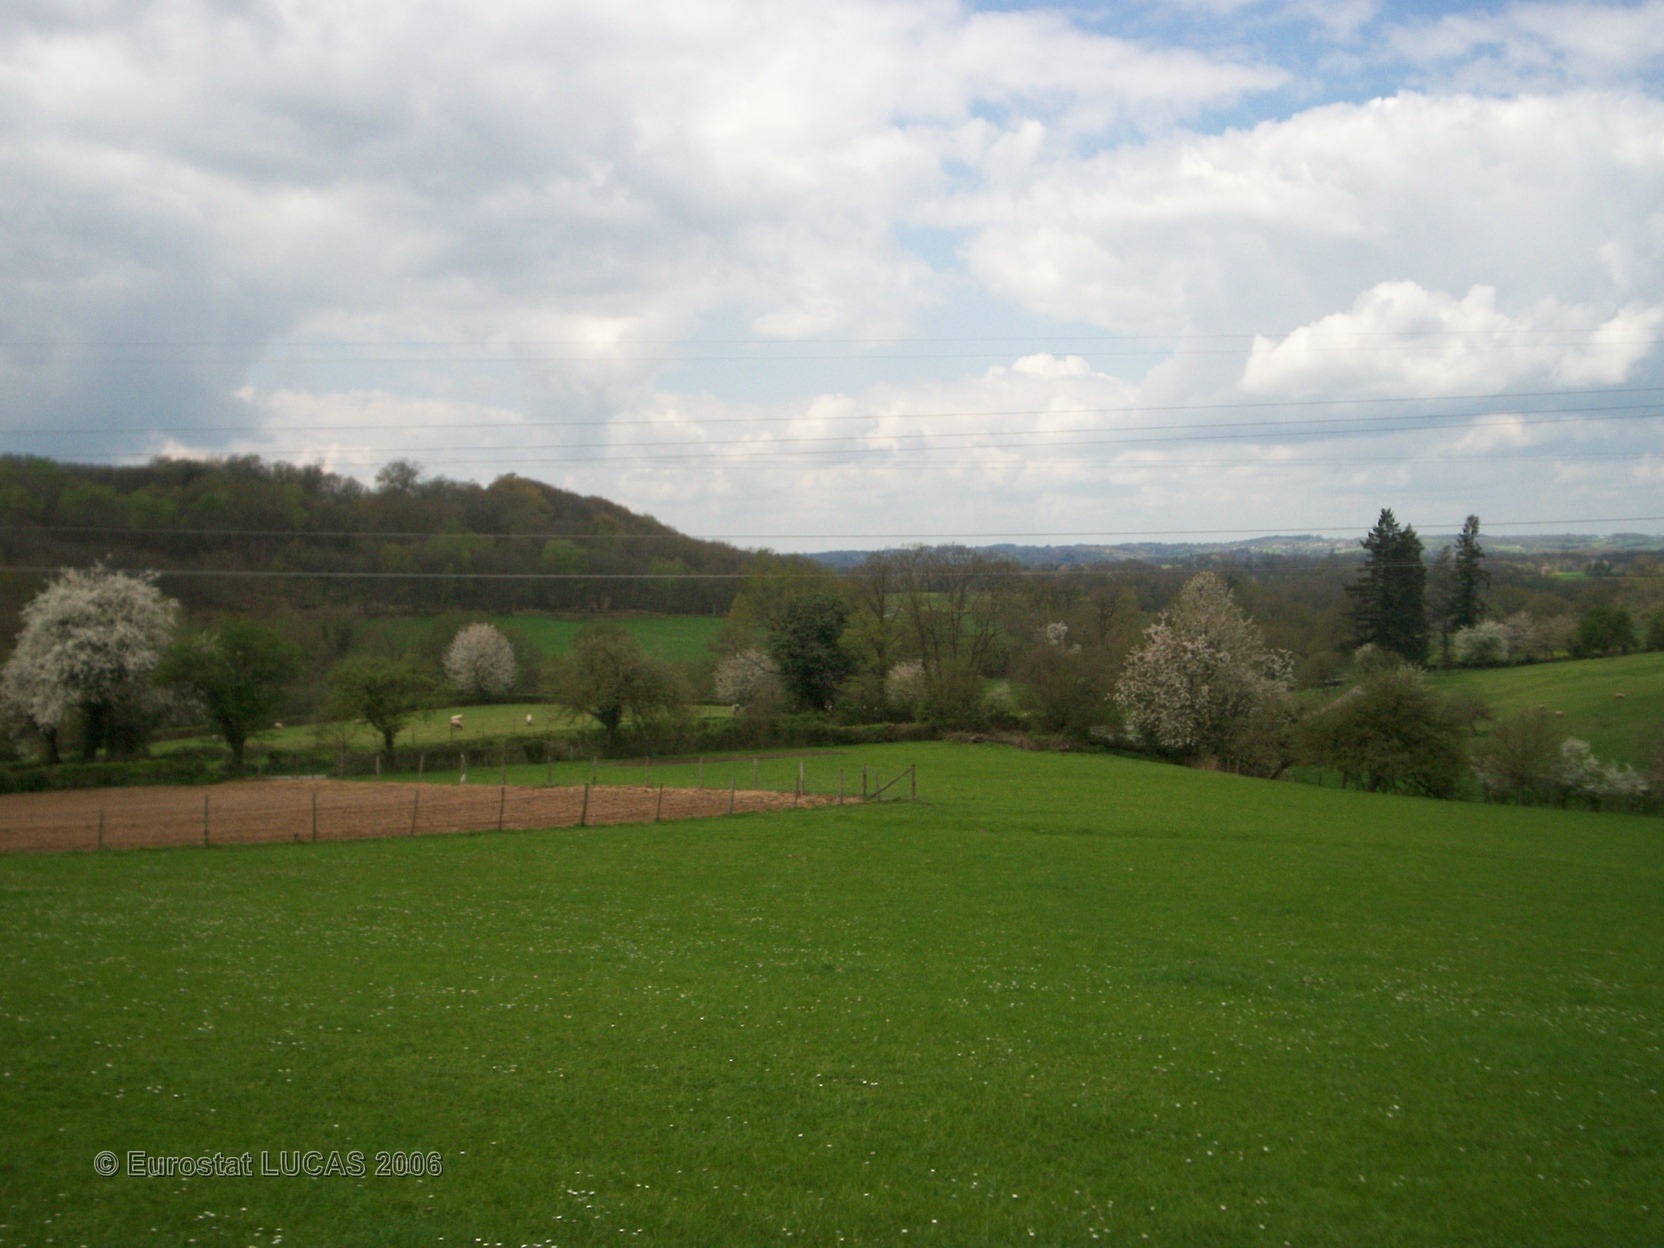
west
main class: Grassland
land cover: Grassland without tree/shrub cover
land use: Agriculture (excluding fallow land and kitchen gardens)
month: April
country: FR
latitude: 46.1881
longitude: 1.6609
